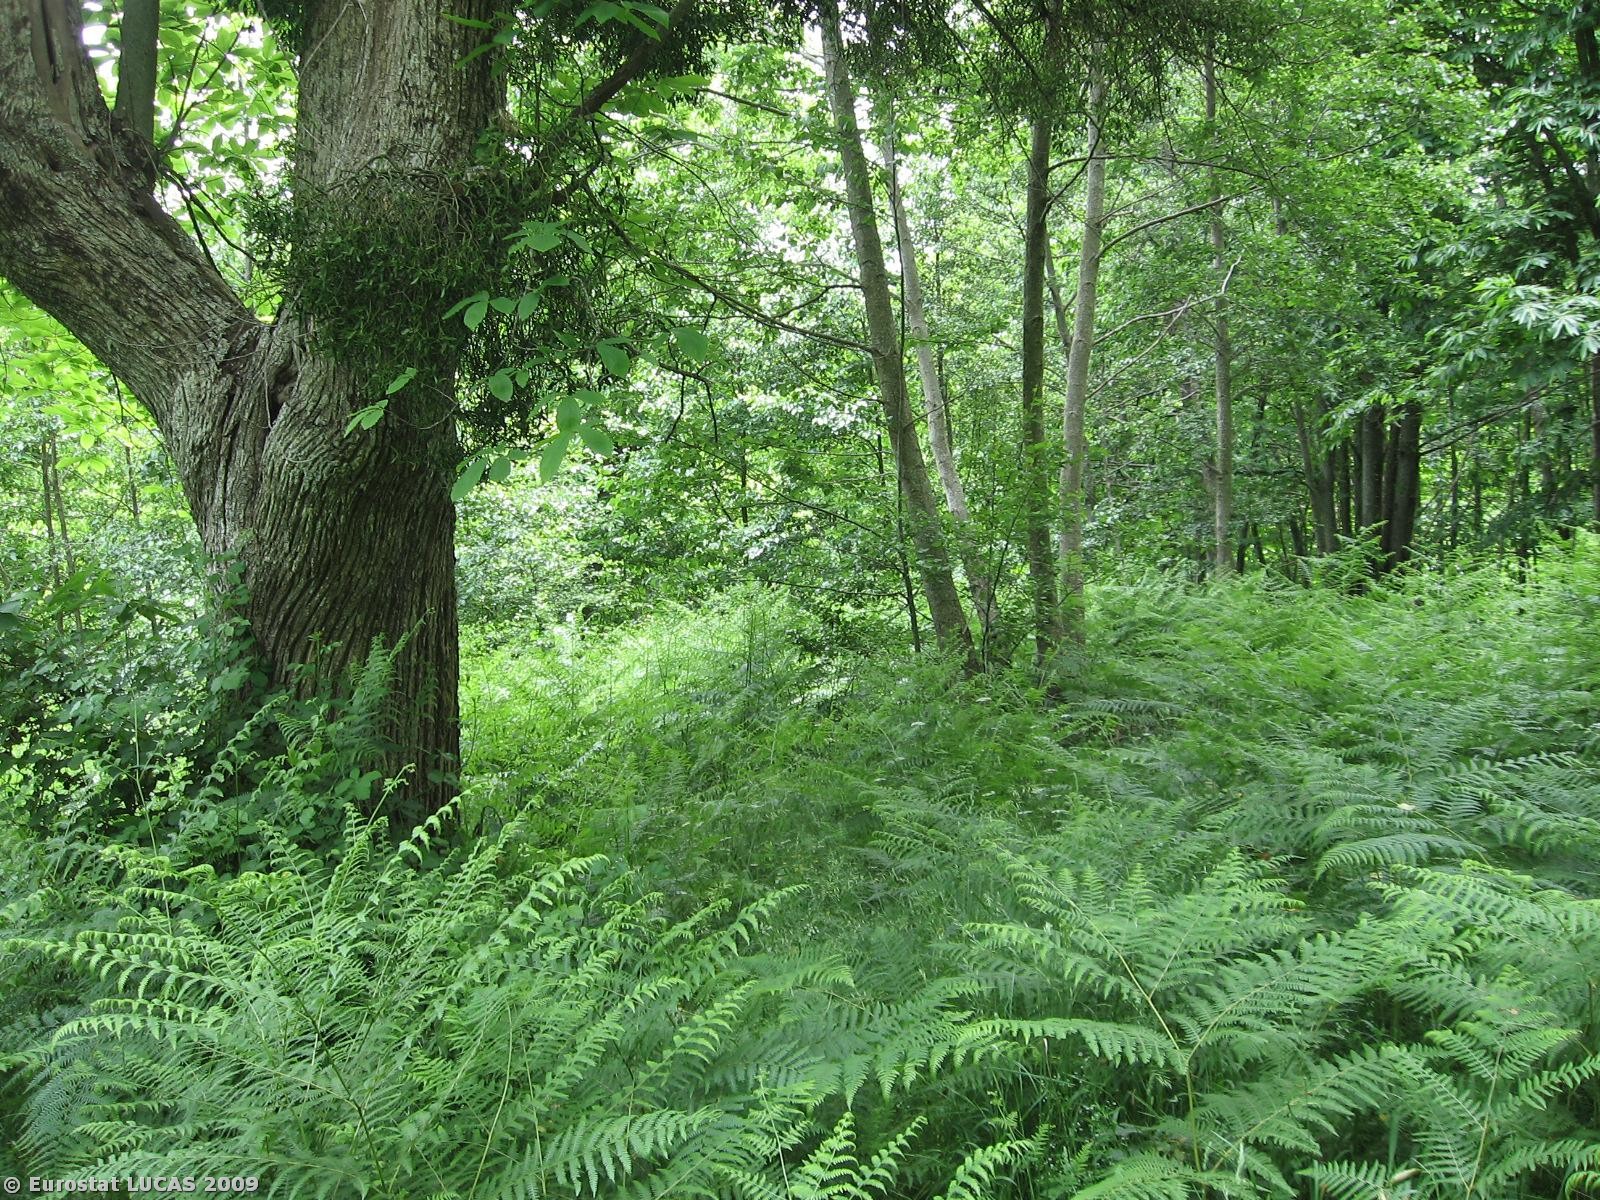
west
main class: Woodland
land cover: Broadleaved woodland
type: thermophilous deciduous forest
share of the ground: > 75 %
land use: Agriculture (excluding fallow land and kitchen gardens)
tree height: > 5 m
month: June
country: IT
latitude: 38.9853
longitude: 16.4202
